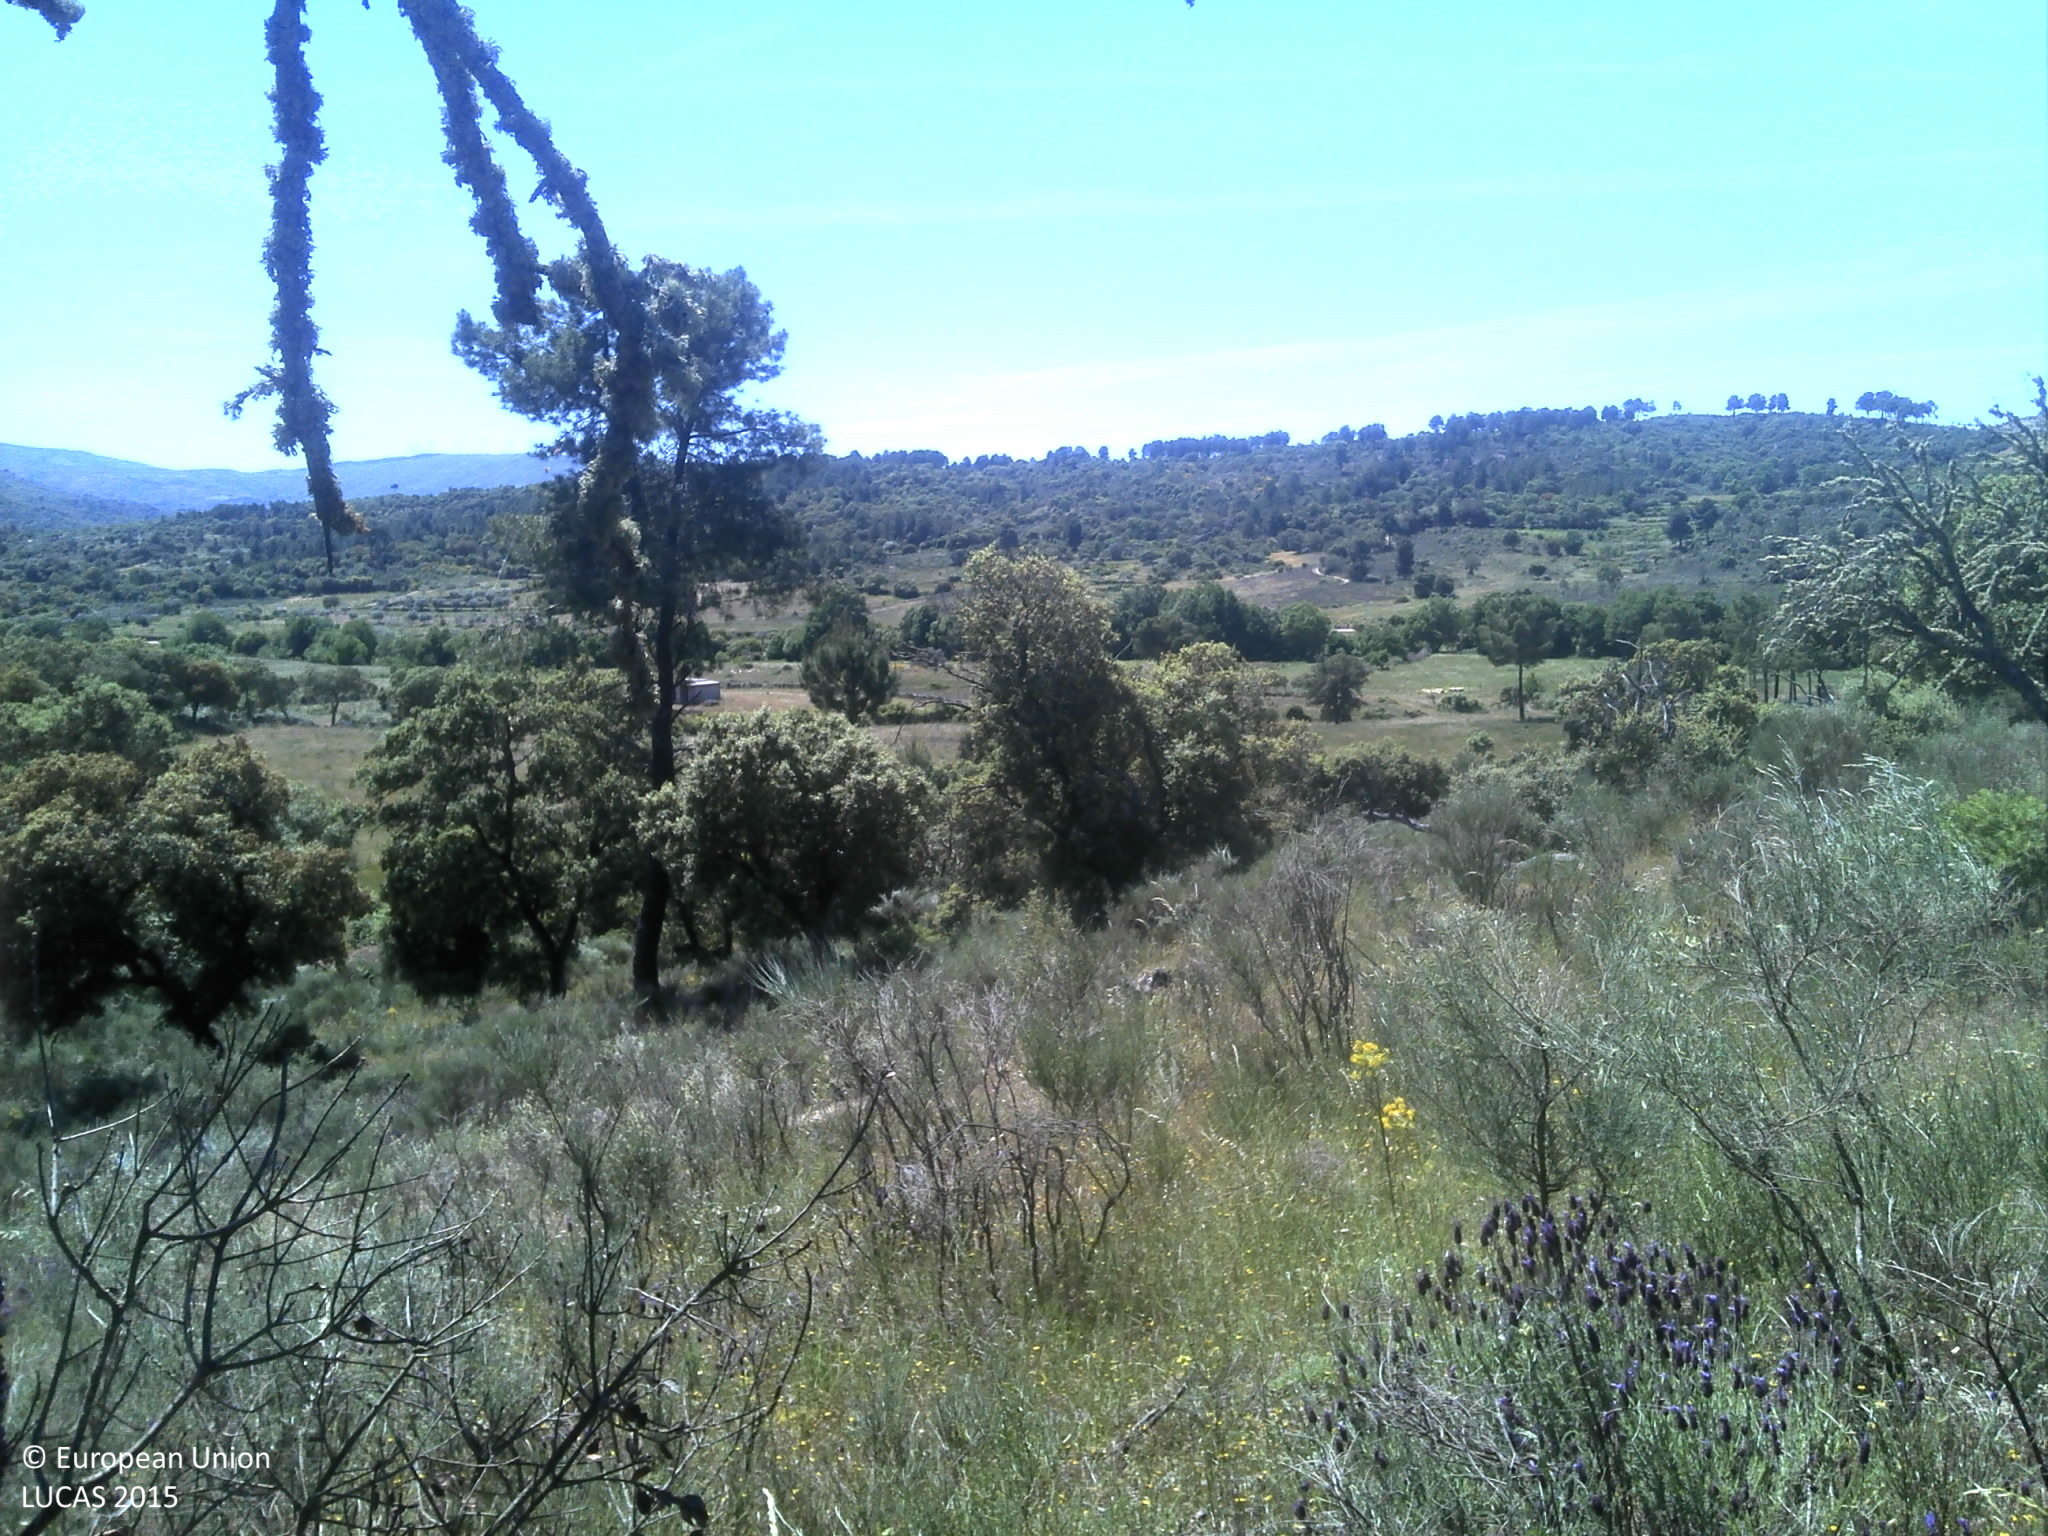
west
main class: Shrubland
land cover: Shrubland with sparse tree cover
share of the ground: 50 - 75 %
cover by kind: shrubs 60 %, herbaceous plants 20 %, unconsolidated bare surface 10 %, broadleaved forest trees 5 %
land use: Abandoned areas
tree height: > 5 m
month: May
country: PT
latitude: 40.6379
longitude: -7.2883
